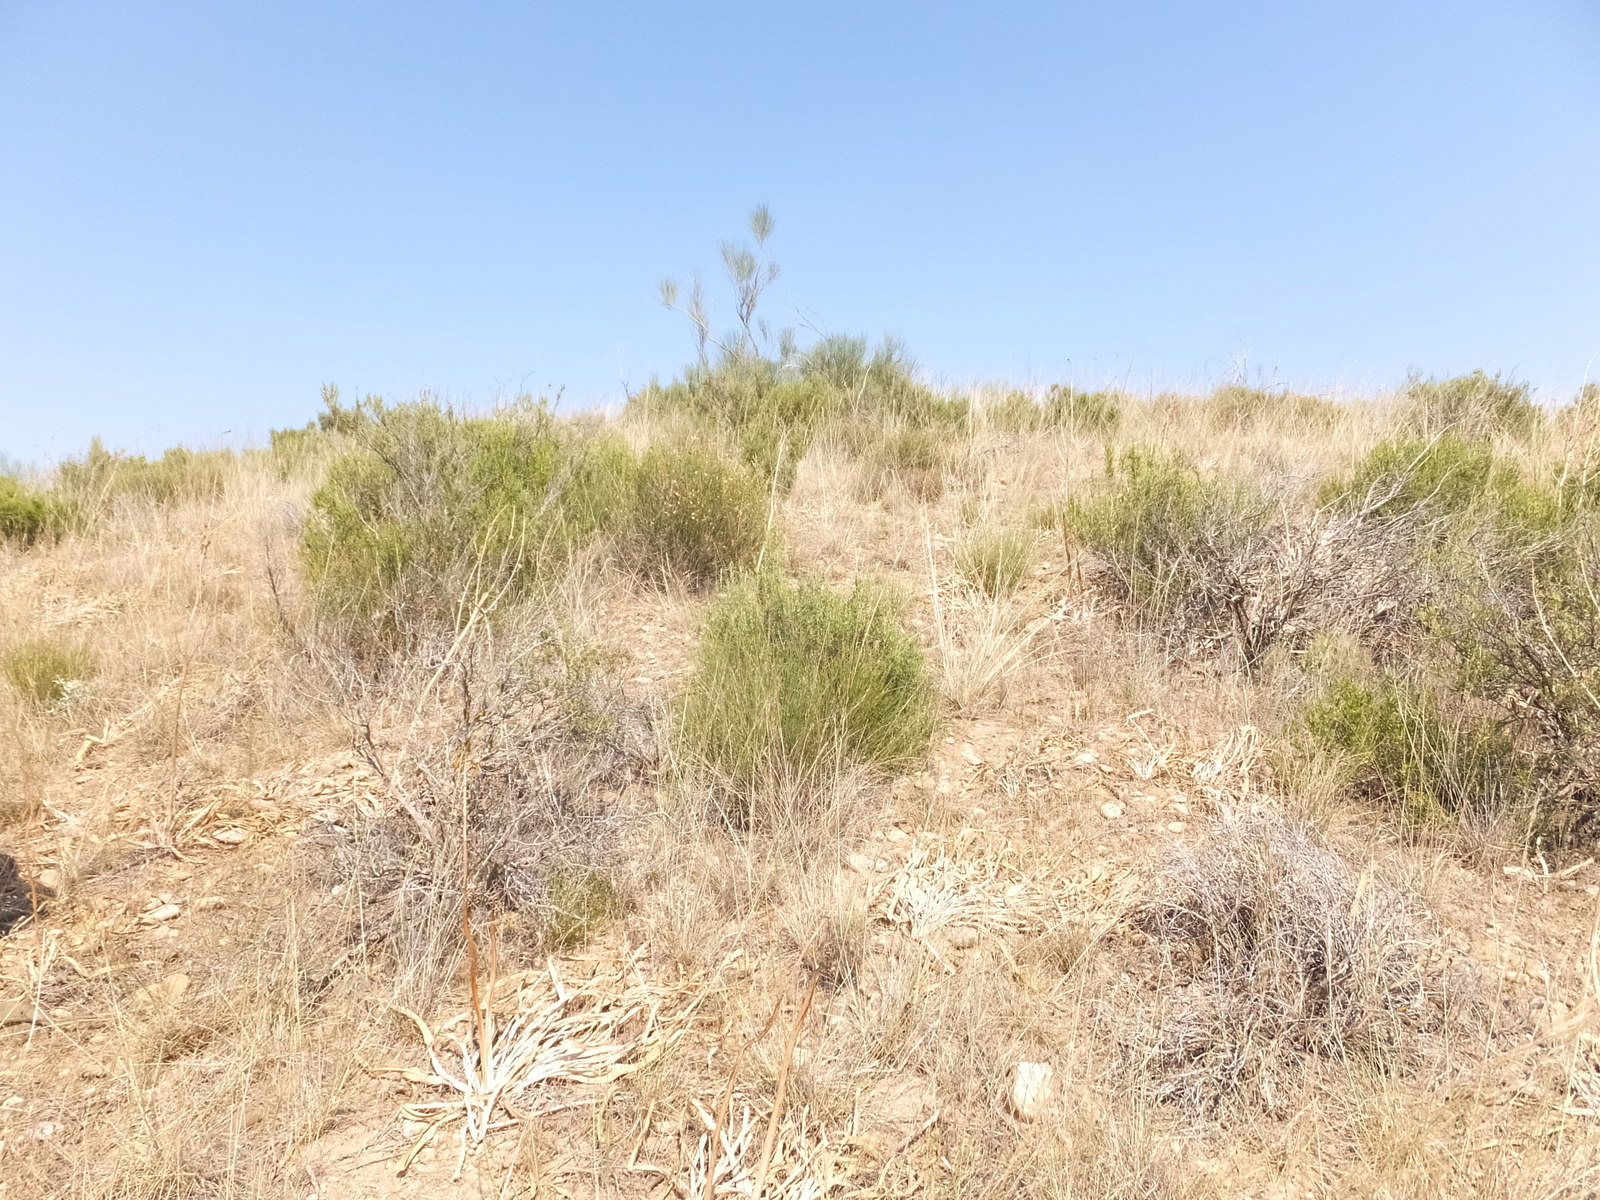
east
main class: Shrubland
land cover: Shrubland with sparse tree cover
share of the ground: 50 - 75 %
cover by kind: shrubs 50 %, herbaceous plants 25 %, consolidated bare surface 20 %, coniferous forest trees 5 %
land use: Semi-natural and natural areas not in use
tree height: < 5 m
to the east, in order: Shrubland with sparse tree cover; Other bare soil
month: June
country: ES
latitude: 41.2494
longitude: -0.1688
